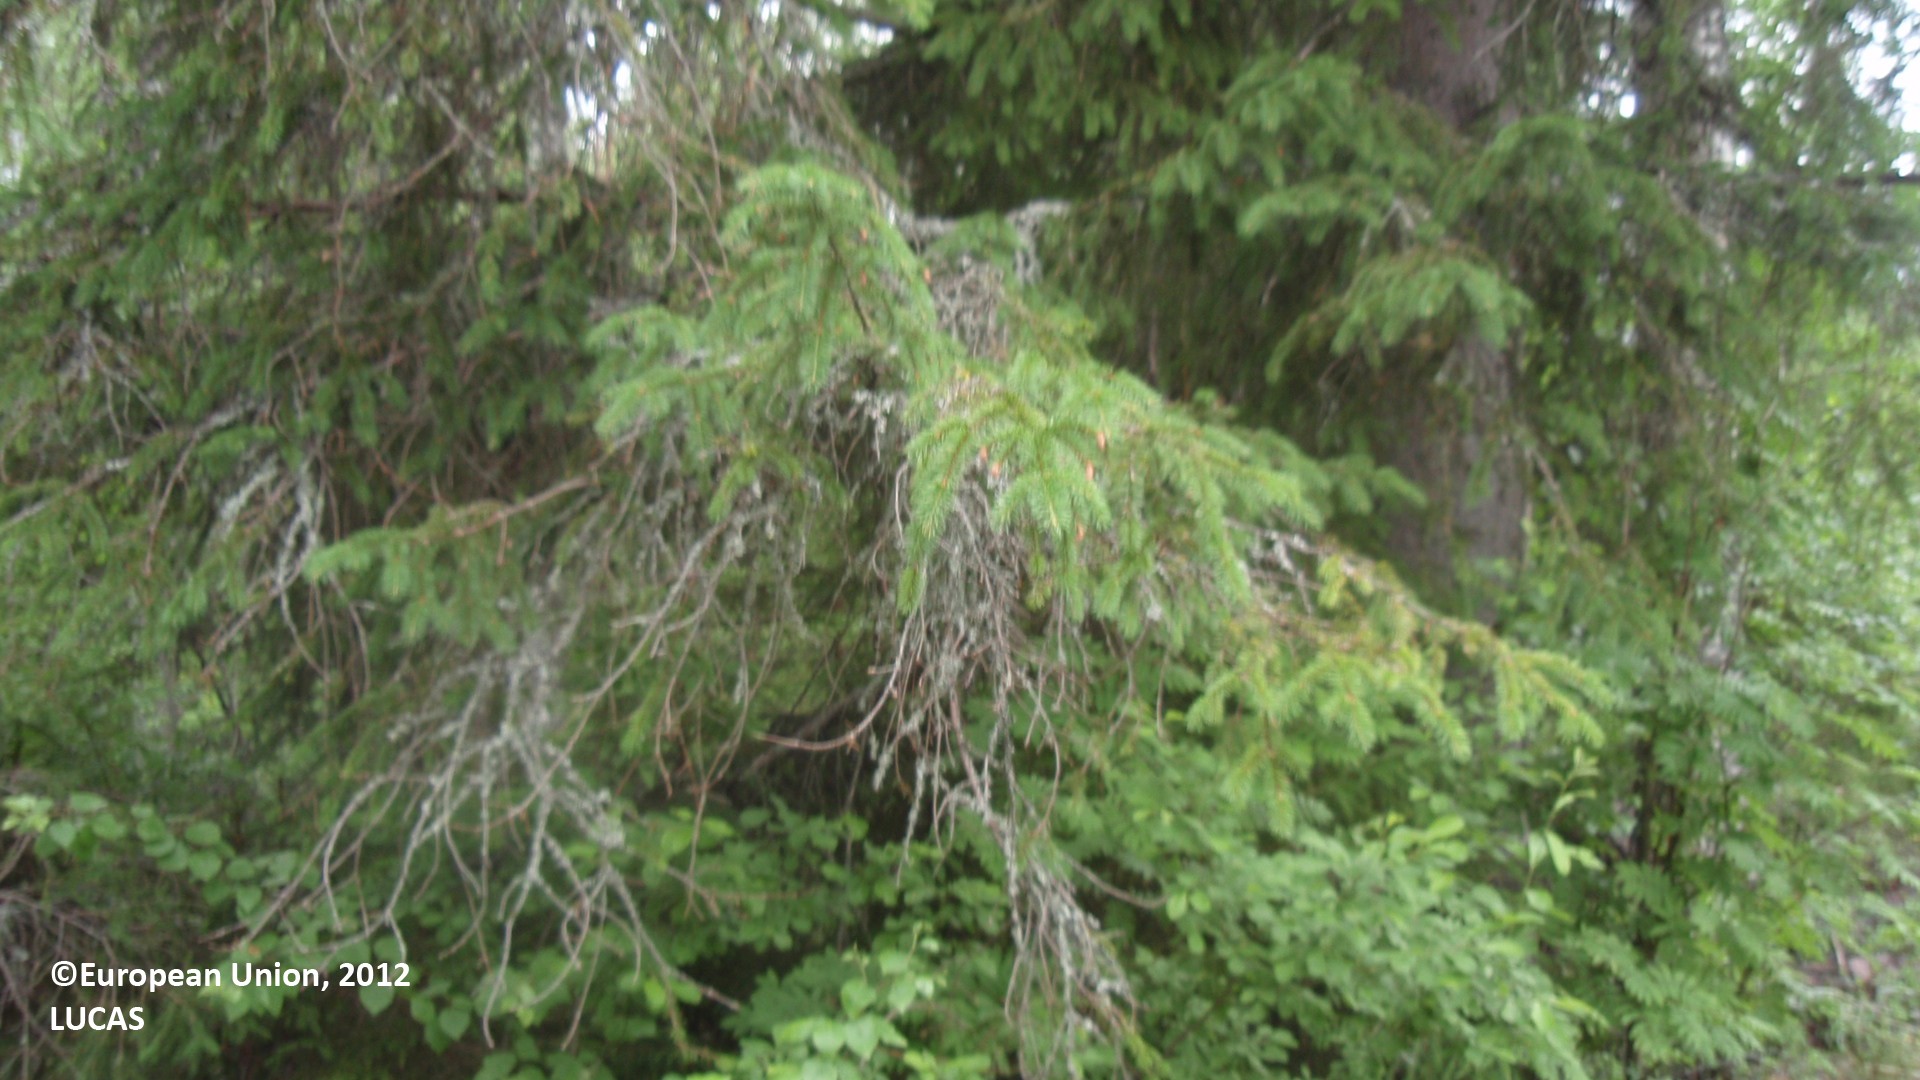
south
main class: Woodland
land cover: Spruce dominated mixed woodland
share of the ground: 50 - 75 %
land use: Forestry
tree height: > 5 m
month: July
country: FI
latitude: 61.4926
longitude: 28.8769
